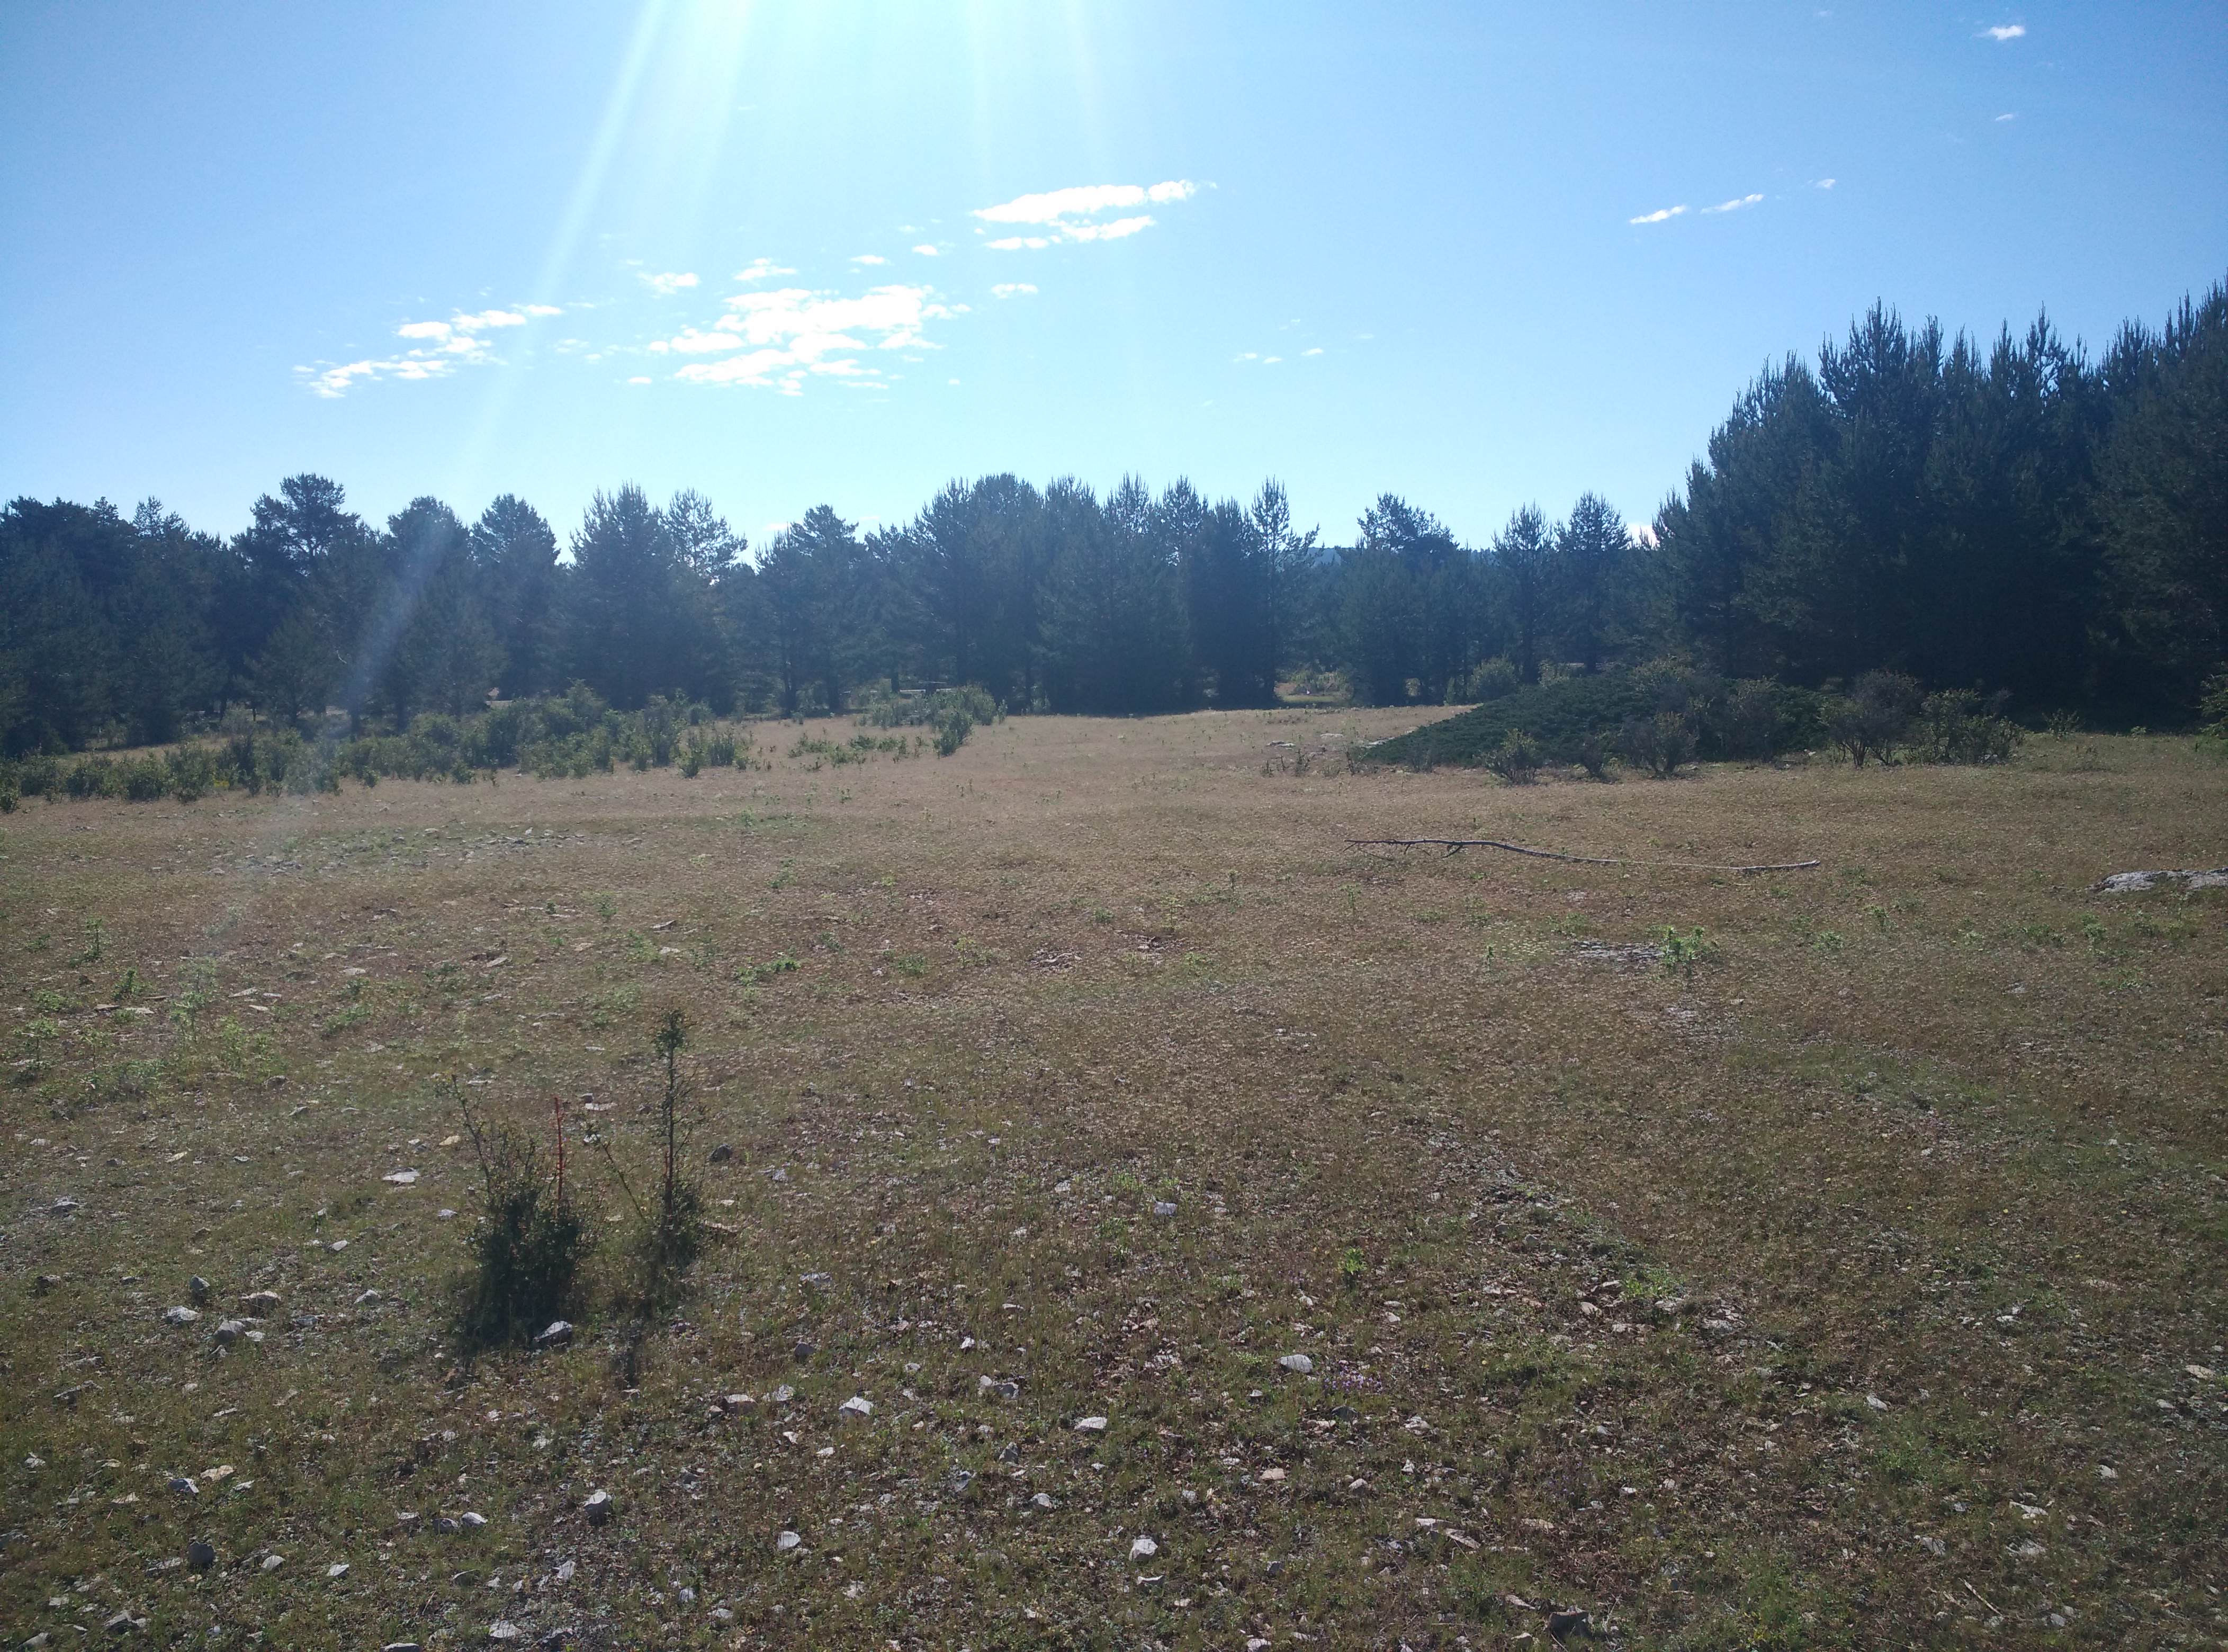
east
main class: Grassland
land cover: Grassland without tree/shrub cover
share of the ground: 50 - 75 %
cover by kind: herbaceous plants 70 %, consolidated bare surface 25 %, unconsolidated bare surface 5 %
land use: Agriculture (excluding fallow land and kitchen gardens)
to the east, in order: Grassland without tree/shrub cover; Pine dominated coniferous woodland; Paved roads, cycling and walking lanes; Shrubland with sparse tree cover; Grassland without tree/shrub cover
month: June
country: ES
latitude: 40.3821
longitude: -1.7361
